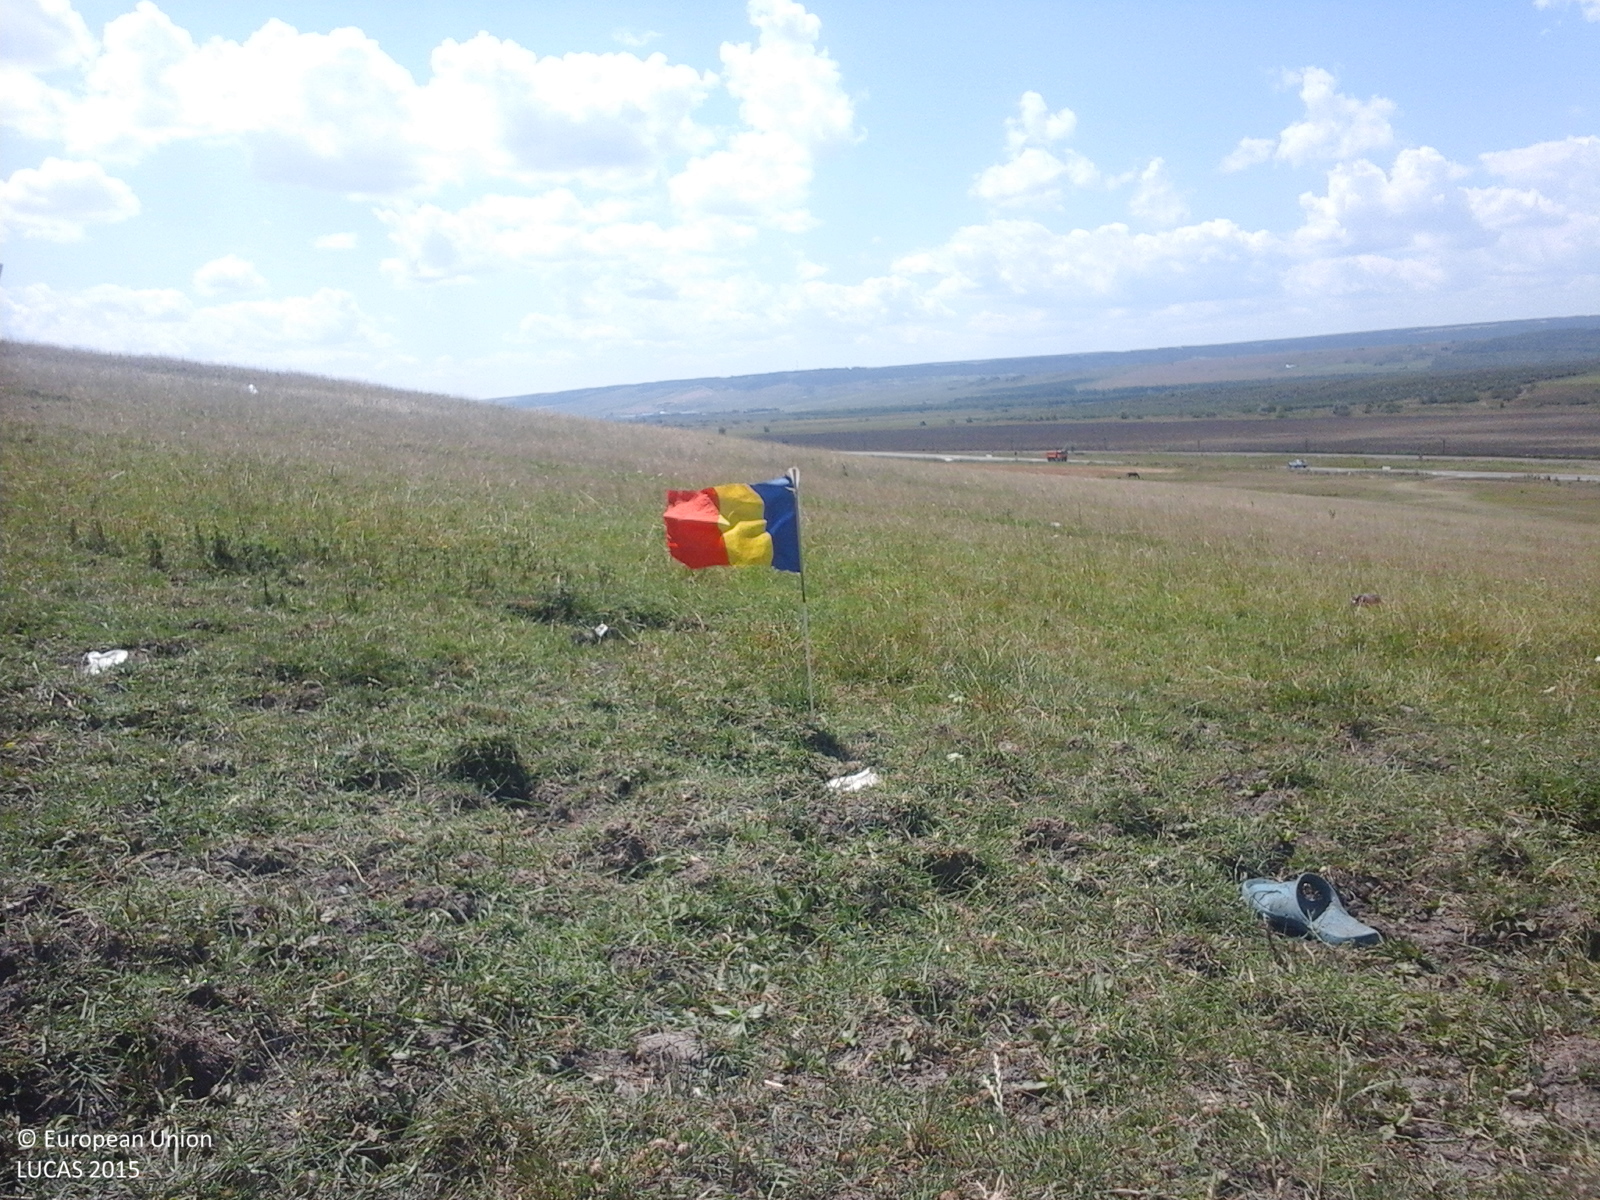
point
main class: Grassland
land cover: Grassland without tree/shrub cover
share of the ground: > 75 %
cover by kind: herbaceous plants 100 %
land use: Agriculture (excluding fallow land and kitchen gardens)
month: July
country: RO
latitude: 46.5312
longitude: 27.8398
